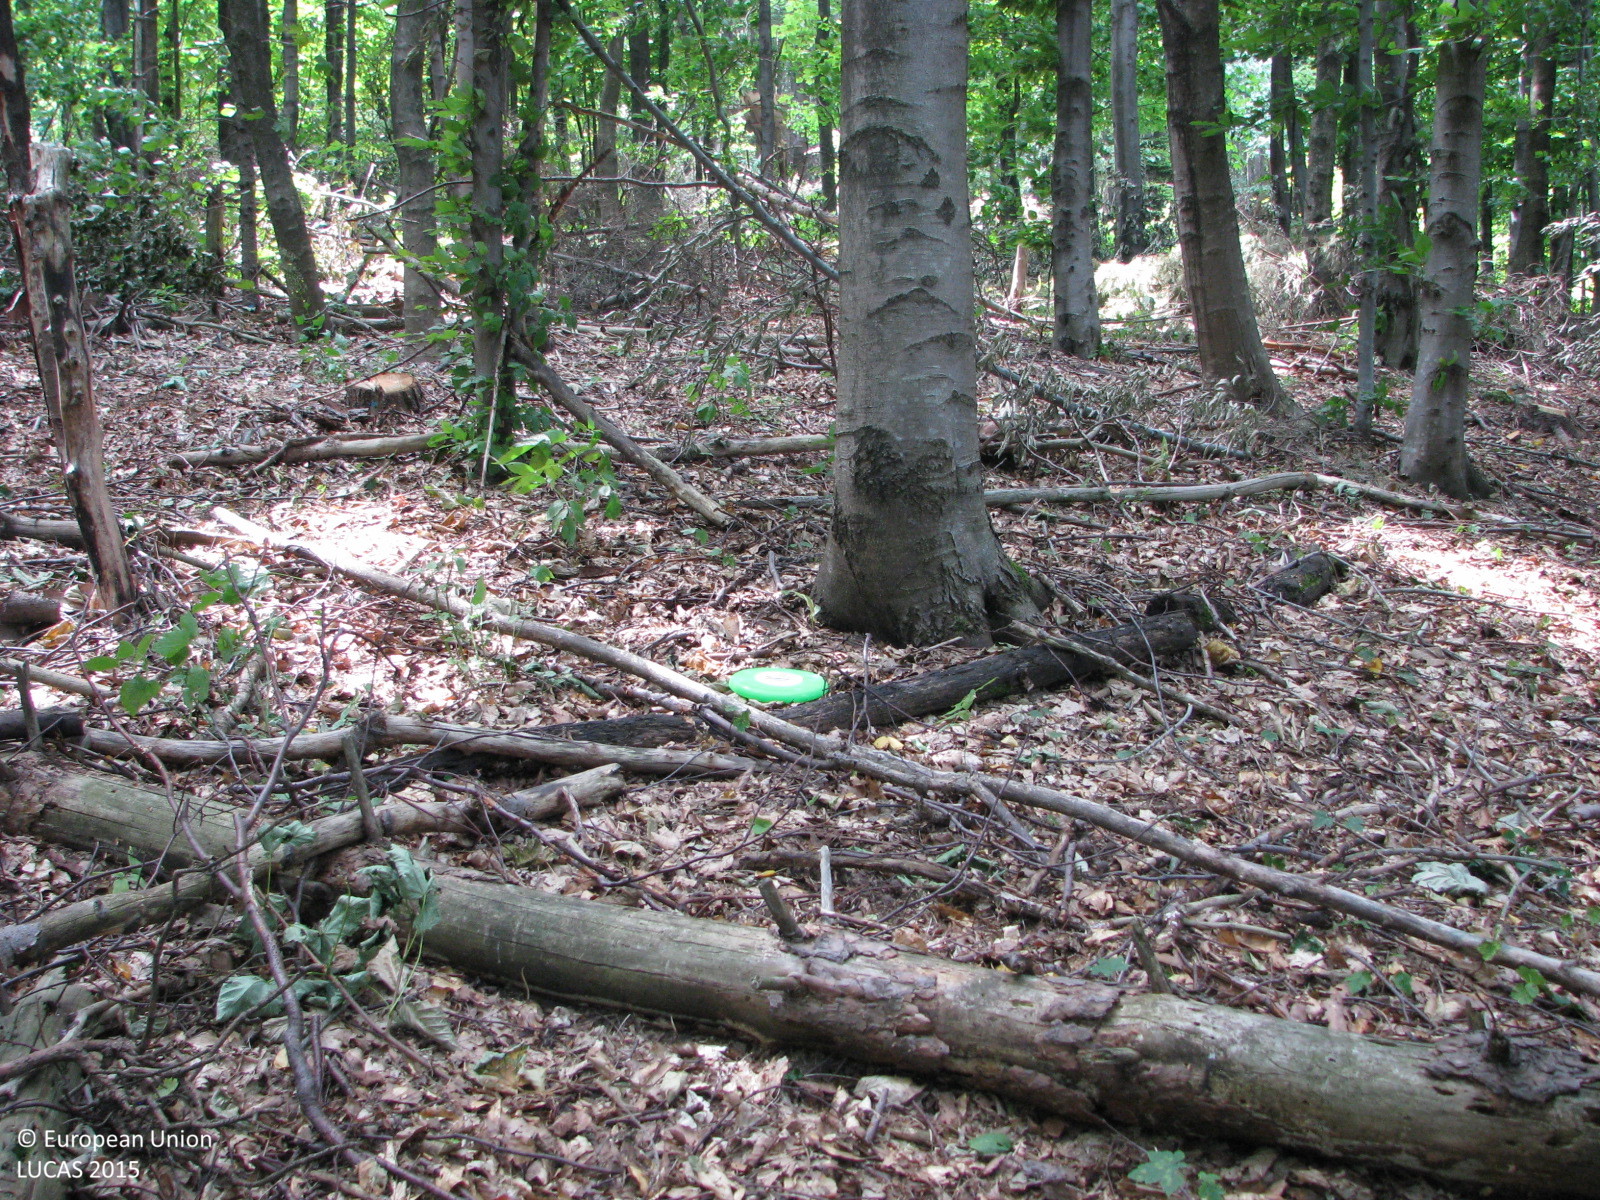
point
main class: Woodland
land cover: Broadleaved woodland
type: beech forest
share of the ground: > 75 %
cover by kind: broadleaved forest trees 75 %, unconsolidated bare surface 20 %, herbaceous plants 5 %
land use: Forestry
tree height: > 5 m
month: August
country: BG
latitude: 42.8109
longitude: 26.1951
